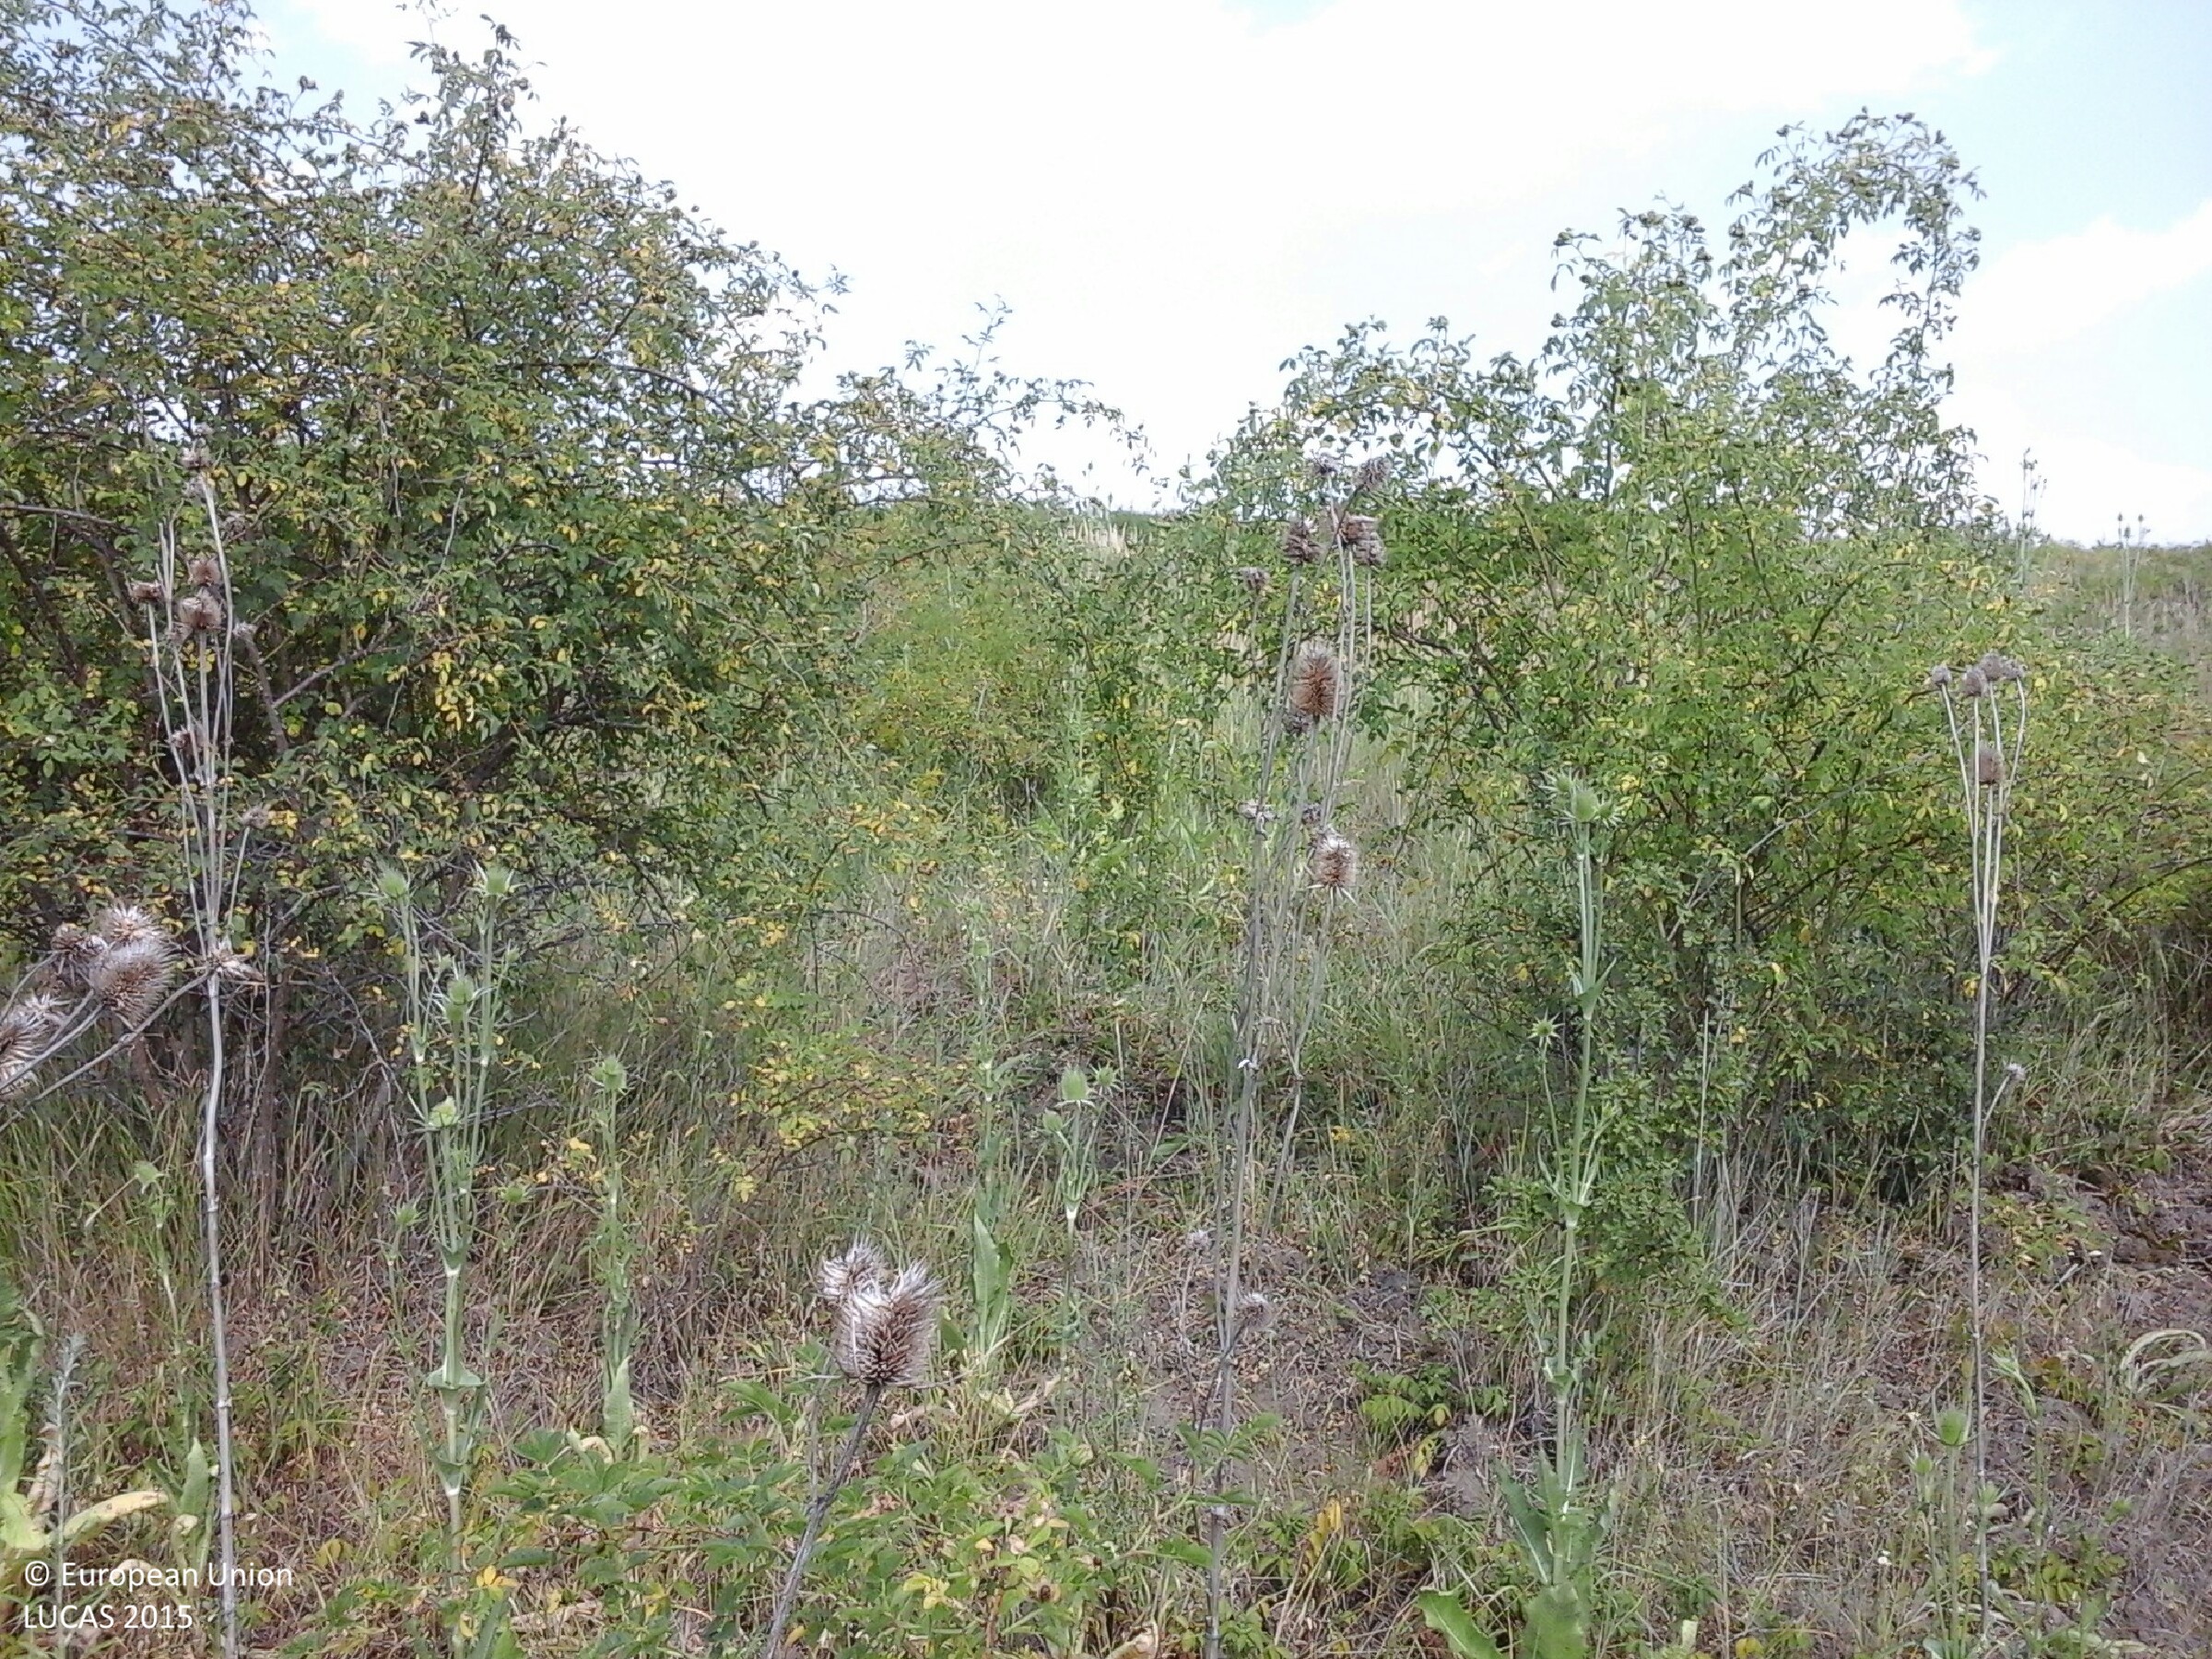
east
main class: Shrubland
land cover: Shrubland without tree cover
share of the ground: 50 - 75 %
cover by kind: shrubs 50 %, herbaceous plants 50 %
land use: Abandoned areas
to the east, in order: Shrubland without tree cover; Maize
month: July
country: HU
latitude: 47.8455
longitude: 20.3335
